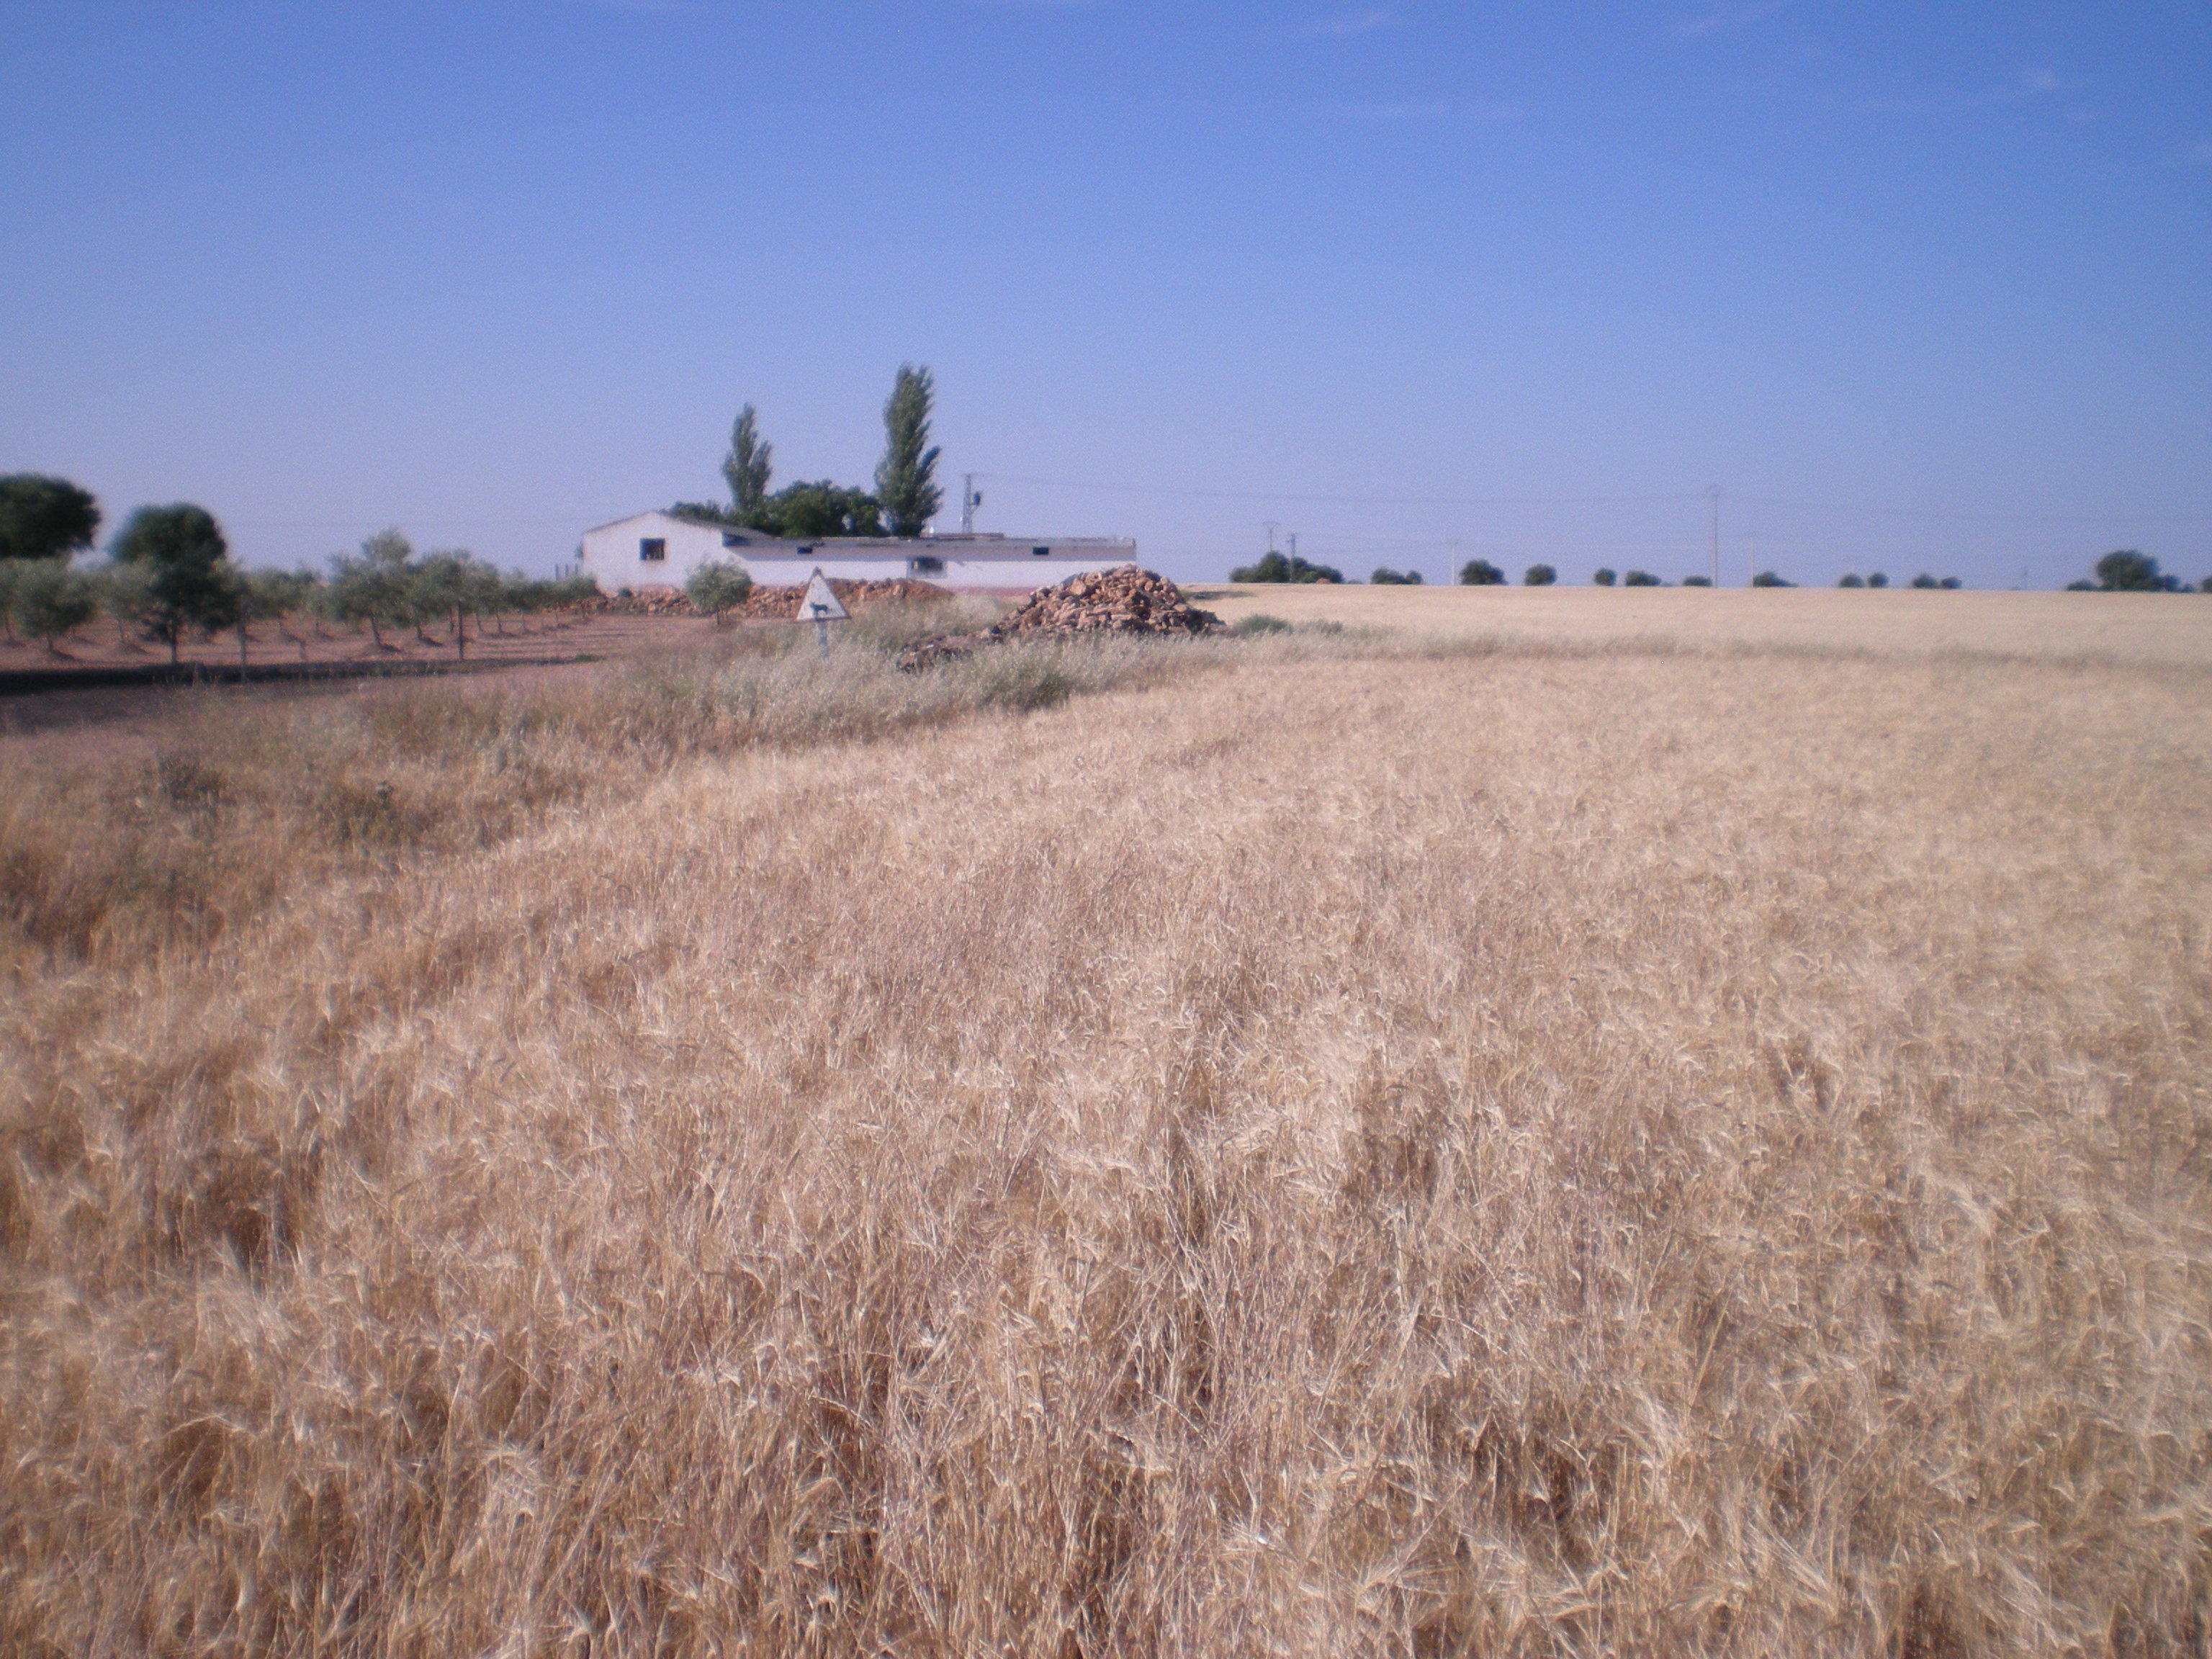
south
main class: Cropland
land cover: Barley
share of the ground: > 75 %
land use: Agriculture (excluding fallow land and kitchen gardens)
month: May
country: ES
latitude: 39.0384
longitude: -3.6153
